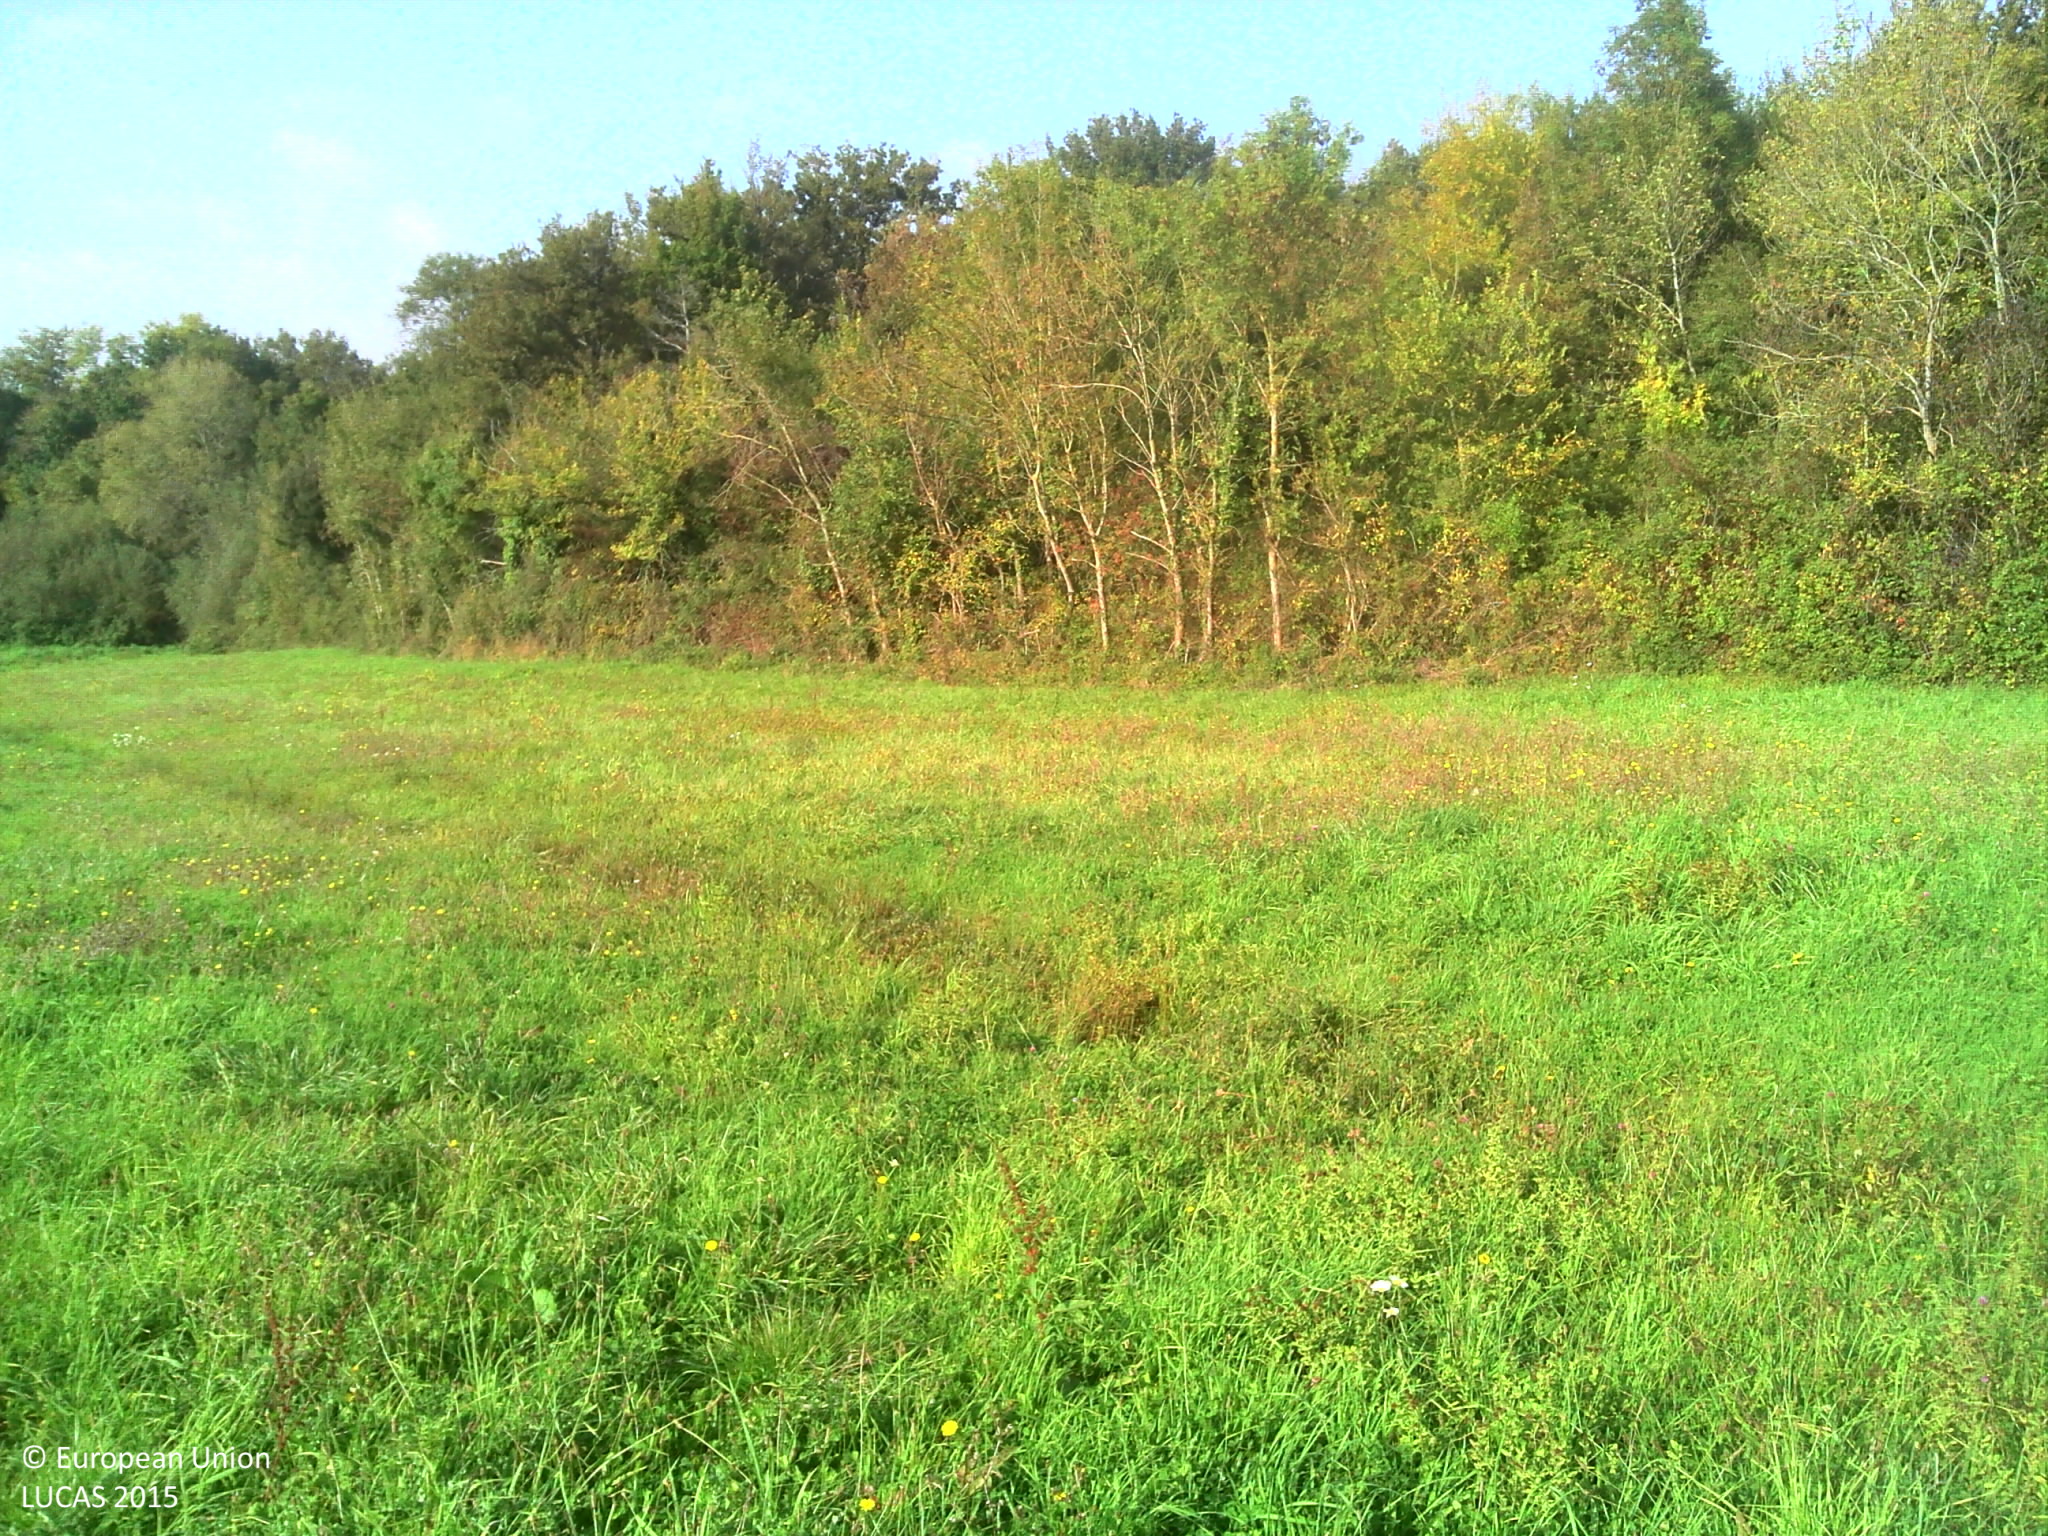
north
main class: Grassland
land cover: Grassland without tree/shrub cover
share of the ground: > 75 %
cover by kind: herbaceous plants 100 %
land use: Agriculture (excluding fallow land and kitchen gardens)
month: October
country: FR
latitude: 46.5077
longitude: -0.8337
